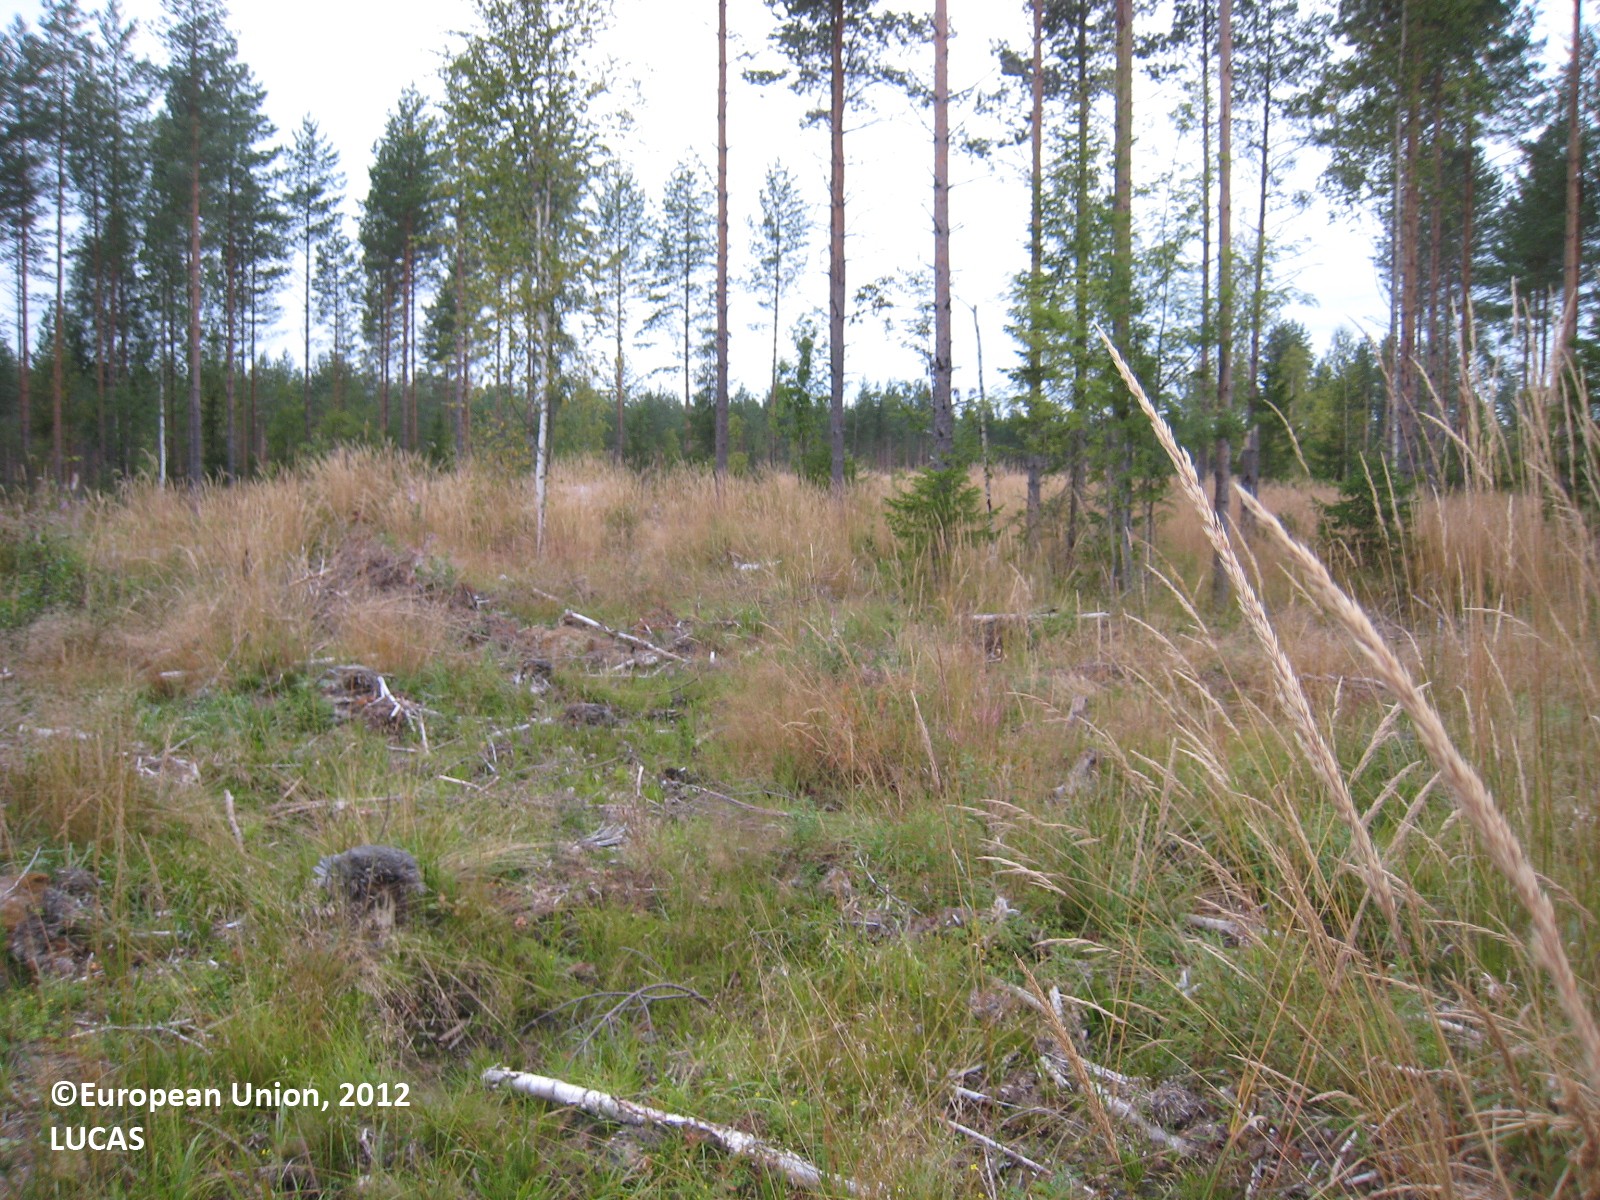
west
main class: Grassland
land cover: Grassland with sparse tree/shrub cover
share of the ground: > 75 %
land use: Forestry
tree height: < 5 m
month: August
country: FI
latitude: 62.3371
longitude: 27.3279
